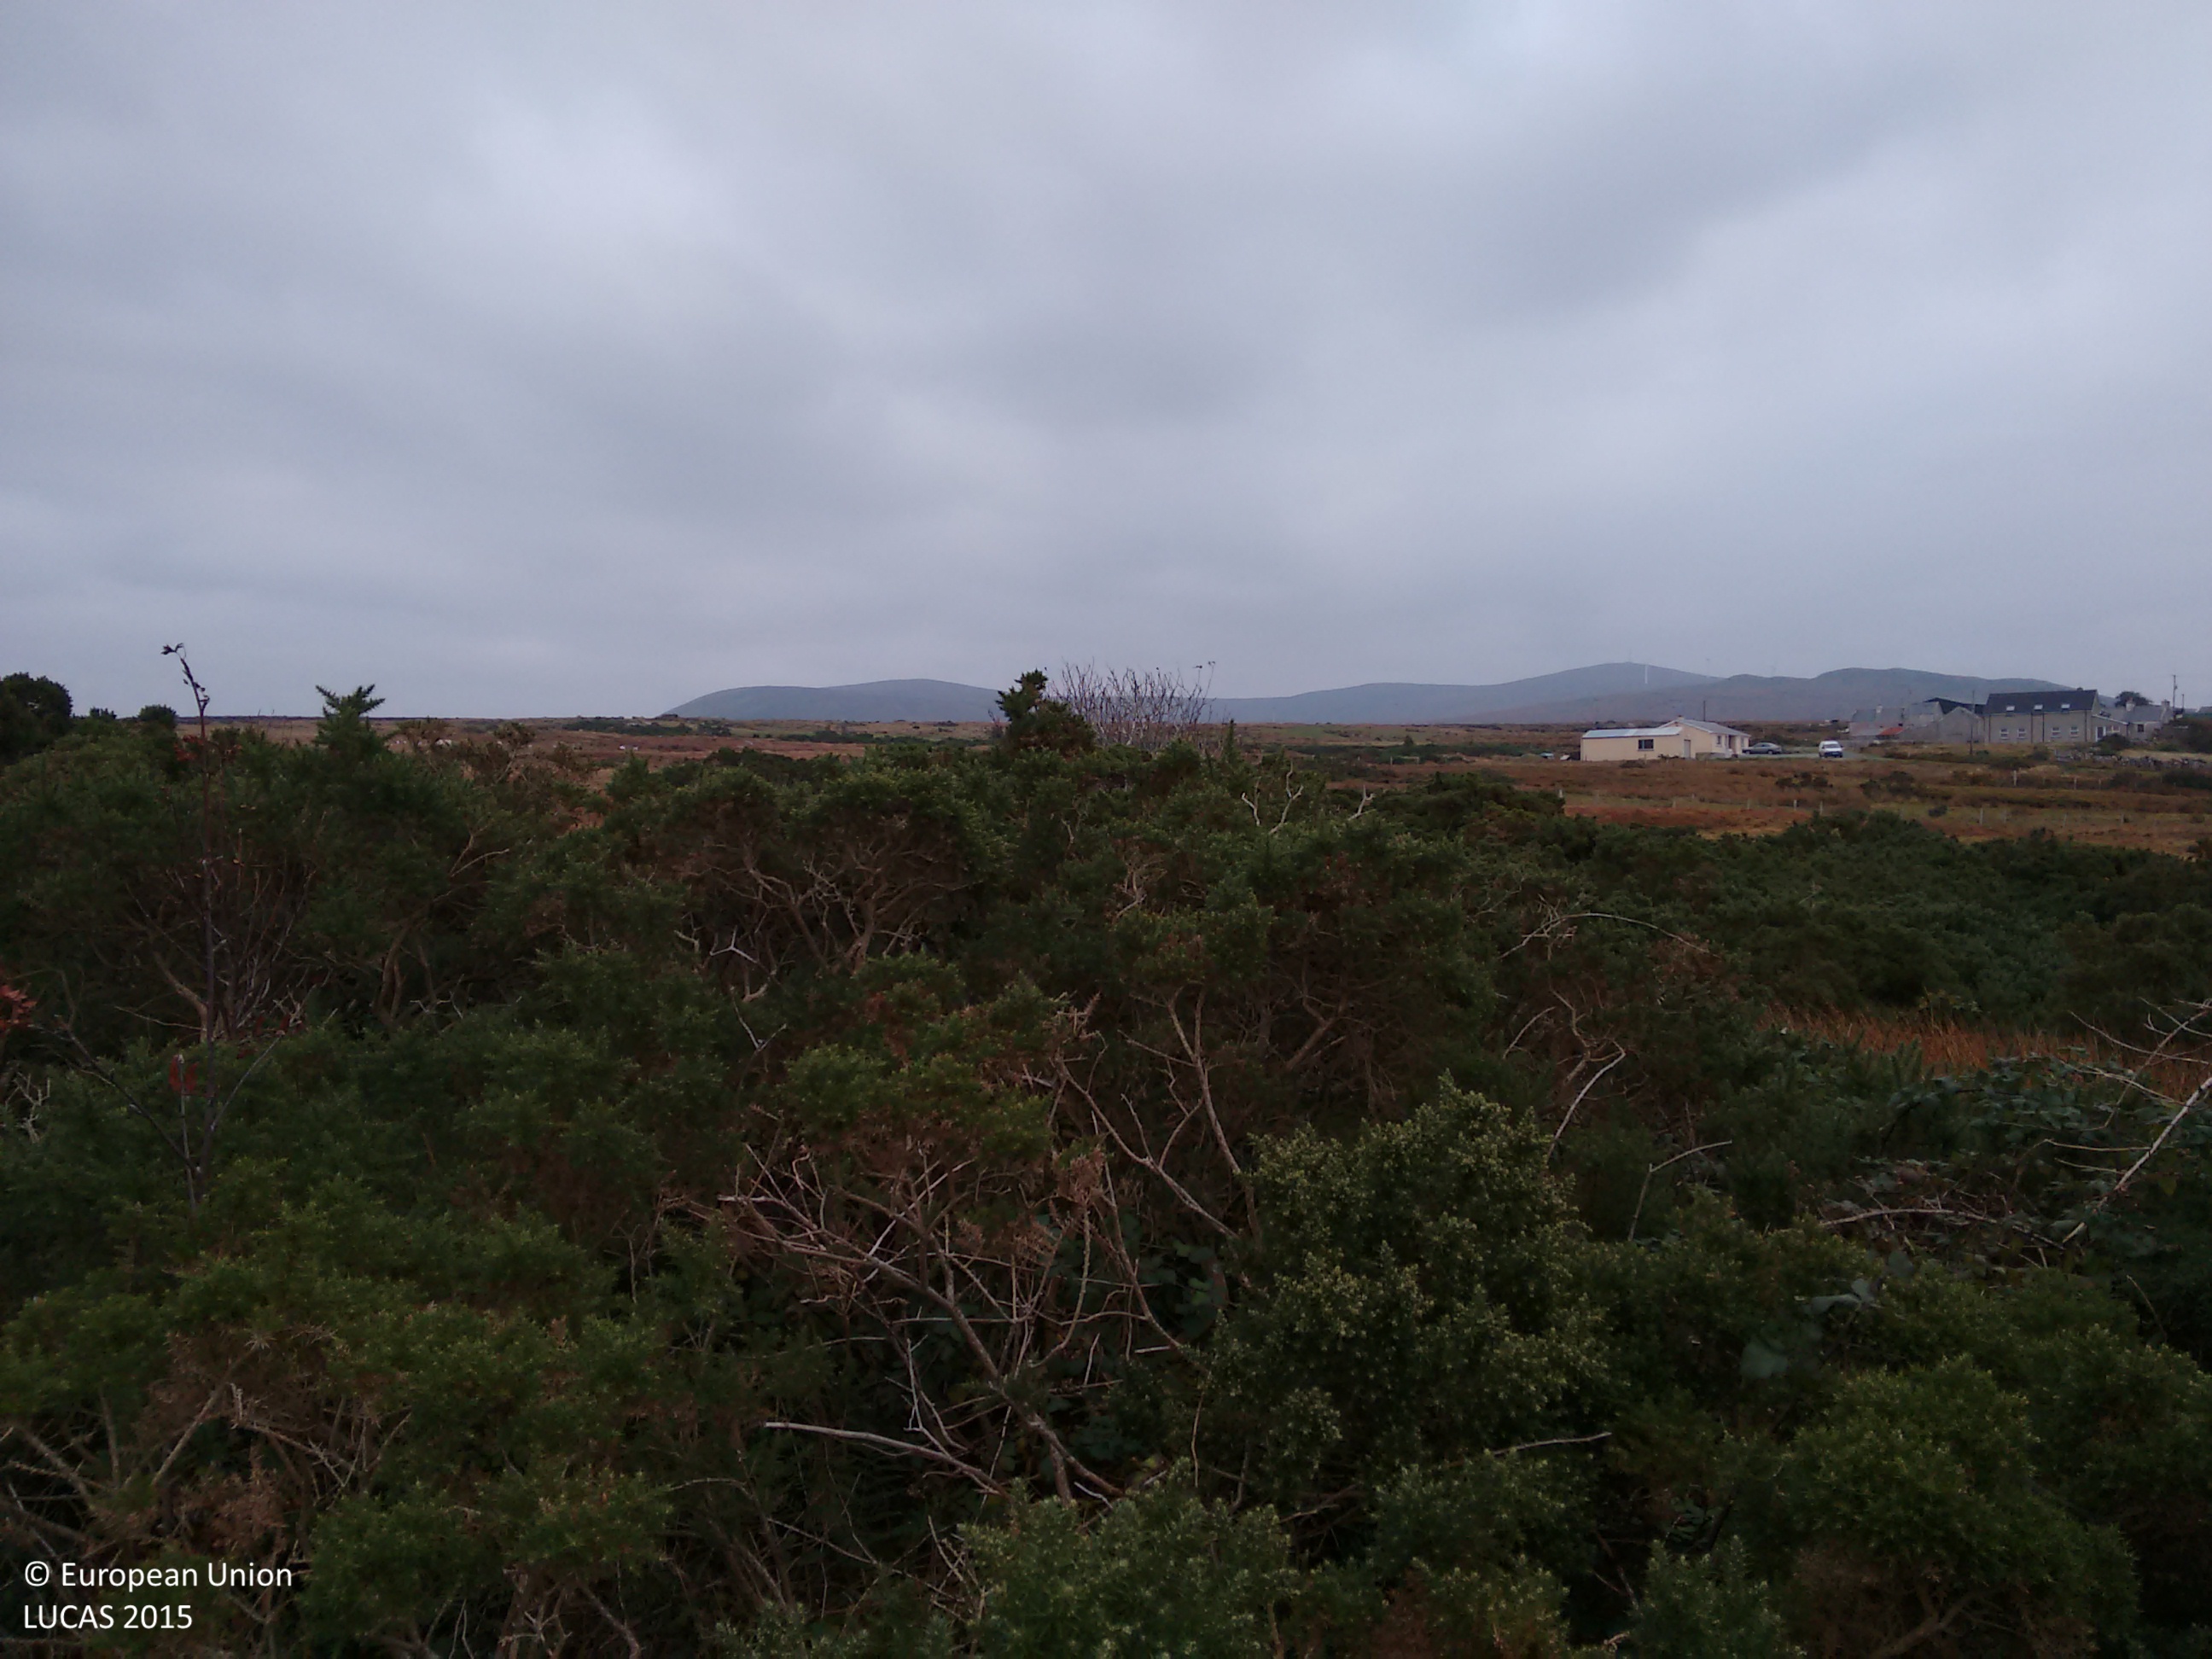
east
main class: Shrubland
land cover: Shrubland without tree cover
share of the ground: > 75 %
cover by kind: shrubs 40 %, herbaceous plants 40 %, lichens and mosses 20 %
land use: Agriculture (excluding fallow land and kitchen gardens)
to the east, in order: Shrubland without tree cover; Ditches and canals; Fences; Grassland without tree/shrub cover; Fences; Shrubland without tree cover; Fences; Ditches and canals; Peatbogs; Tracks; Ditches and canals; Peatbogs
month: November
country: IE
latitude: 55.0797
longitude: -8.2728
